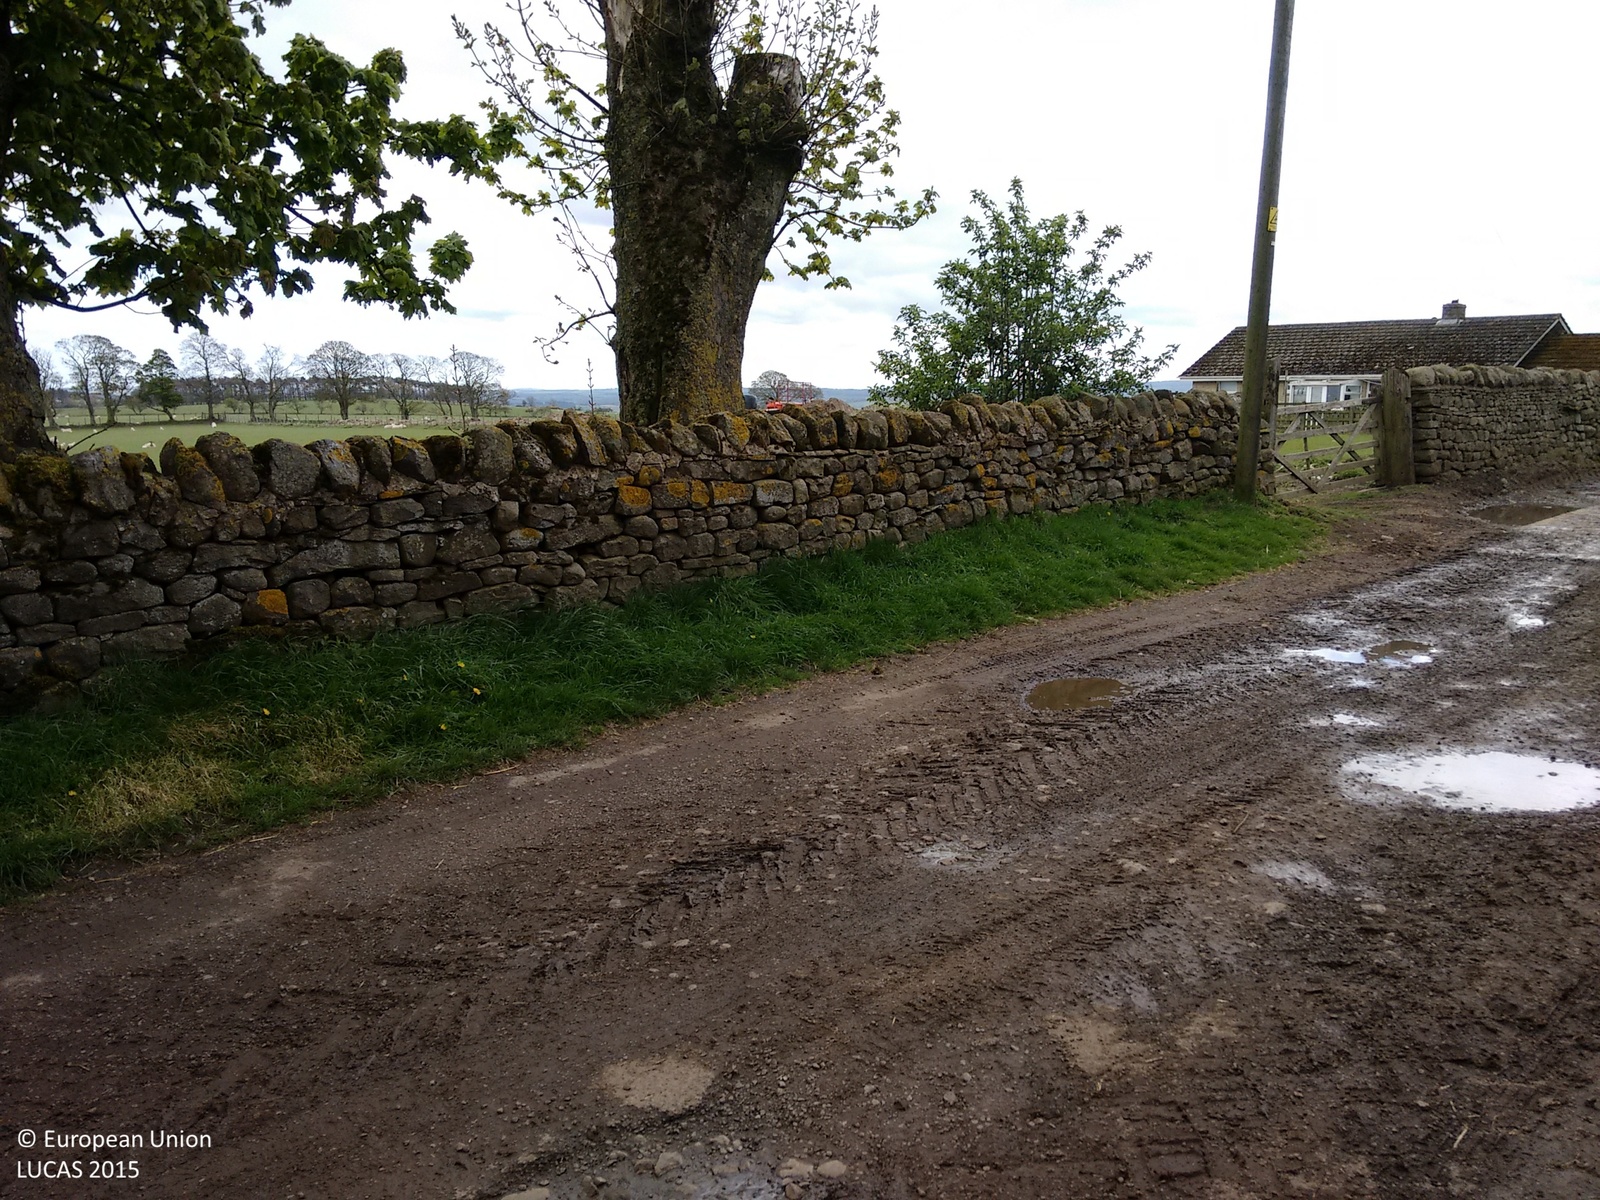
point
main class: Grassland
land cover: Grassland without tree/shrub cover
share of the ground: > 75 %
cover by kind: herbaceous plants 100 %
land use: Agriculture (excluding fallow land and kitchen gardens)
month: May
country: GB
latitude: 54.9517
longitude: -2.1582
